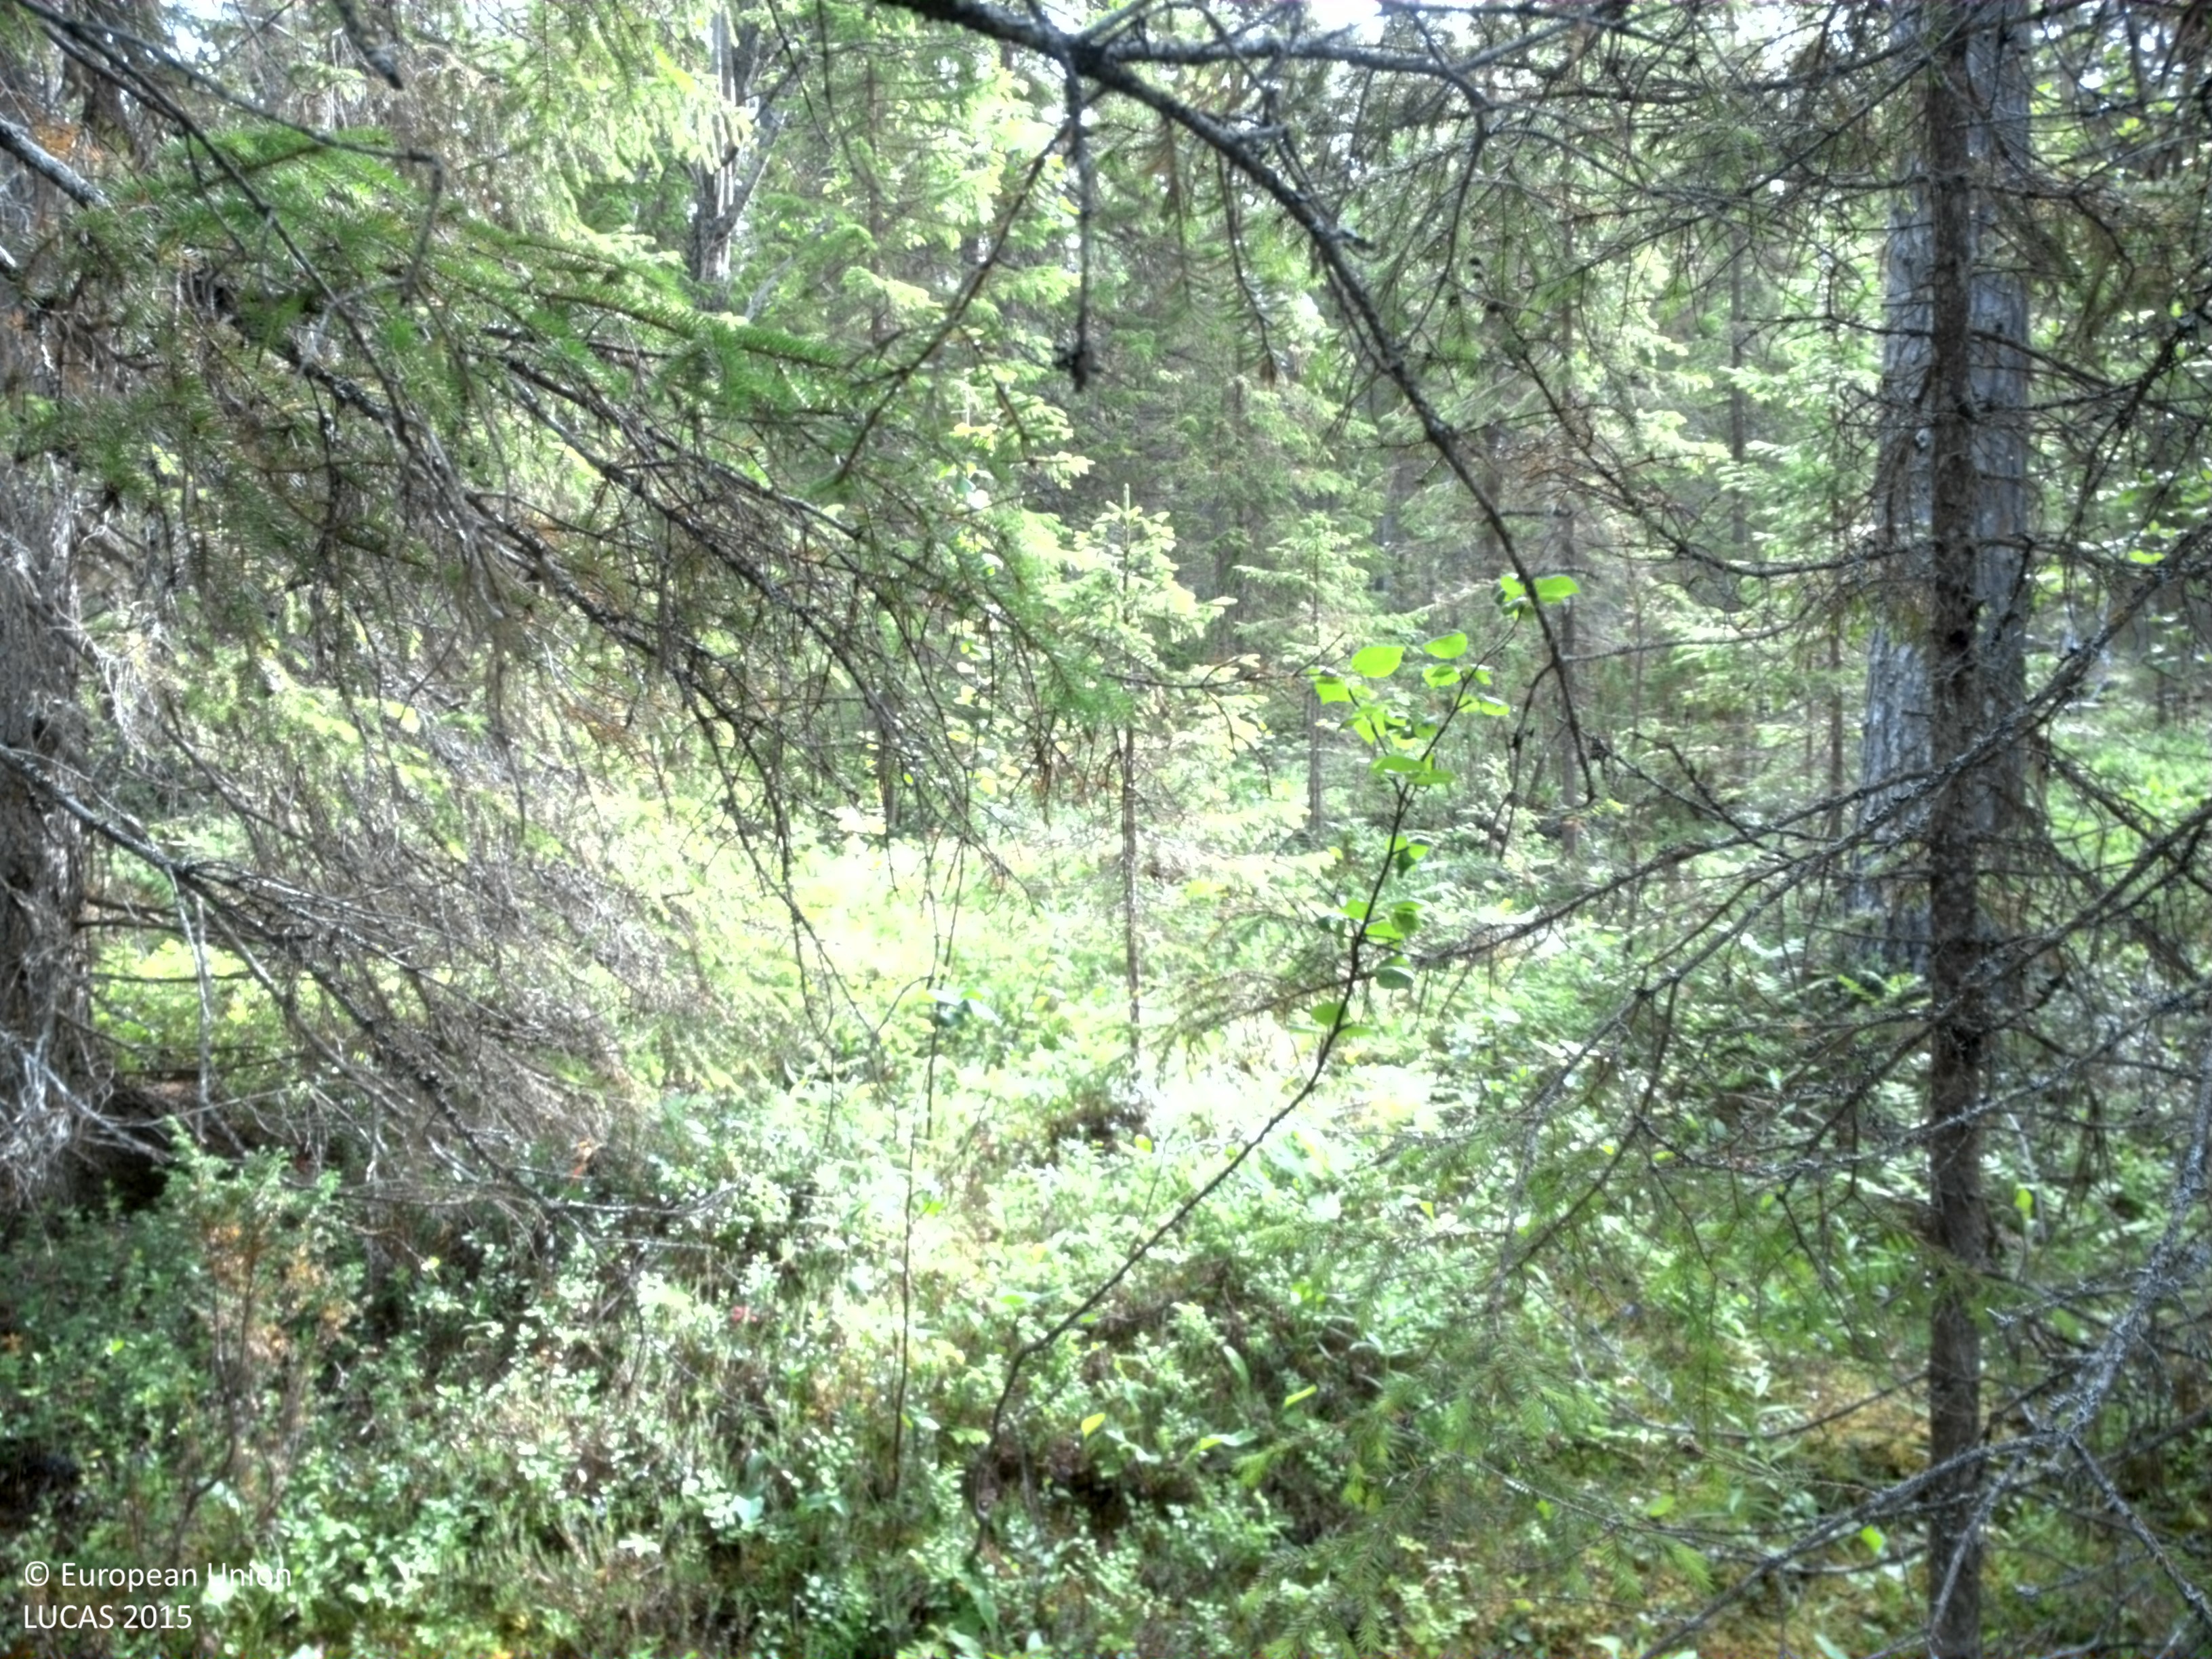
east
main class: Woodland
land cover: Spruce dominated coniferous woodland
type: boreal forest
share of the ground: 50 - 75 %
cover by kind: coniferous forest trees 50 %, shrubs 35 %, lichens and mosses 10 %, herbaceous plants 5 %
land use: Forestry
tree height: > 5 m
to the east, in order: Spruce dominated coniferous woodland; Spruce dominated mixed woodland; Spruce dominated coniferous woodland
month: August
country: SE
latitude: 64.9386
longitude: 15.9541
